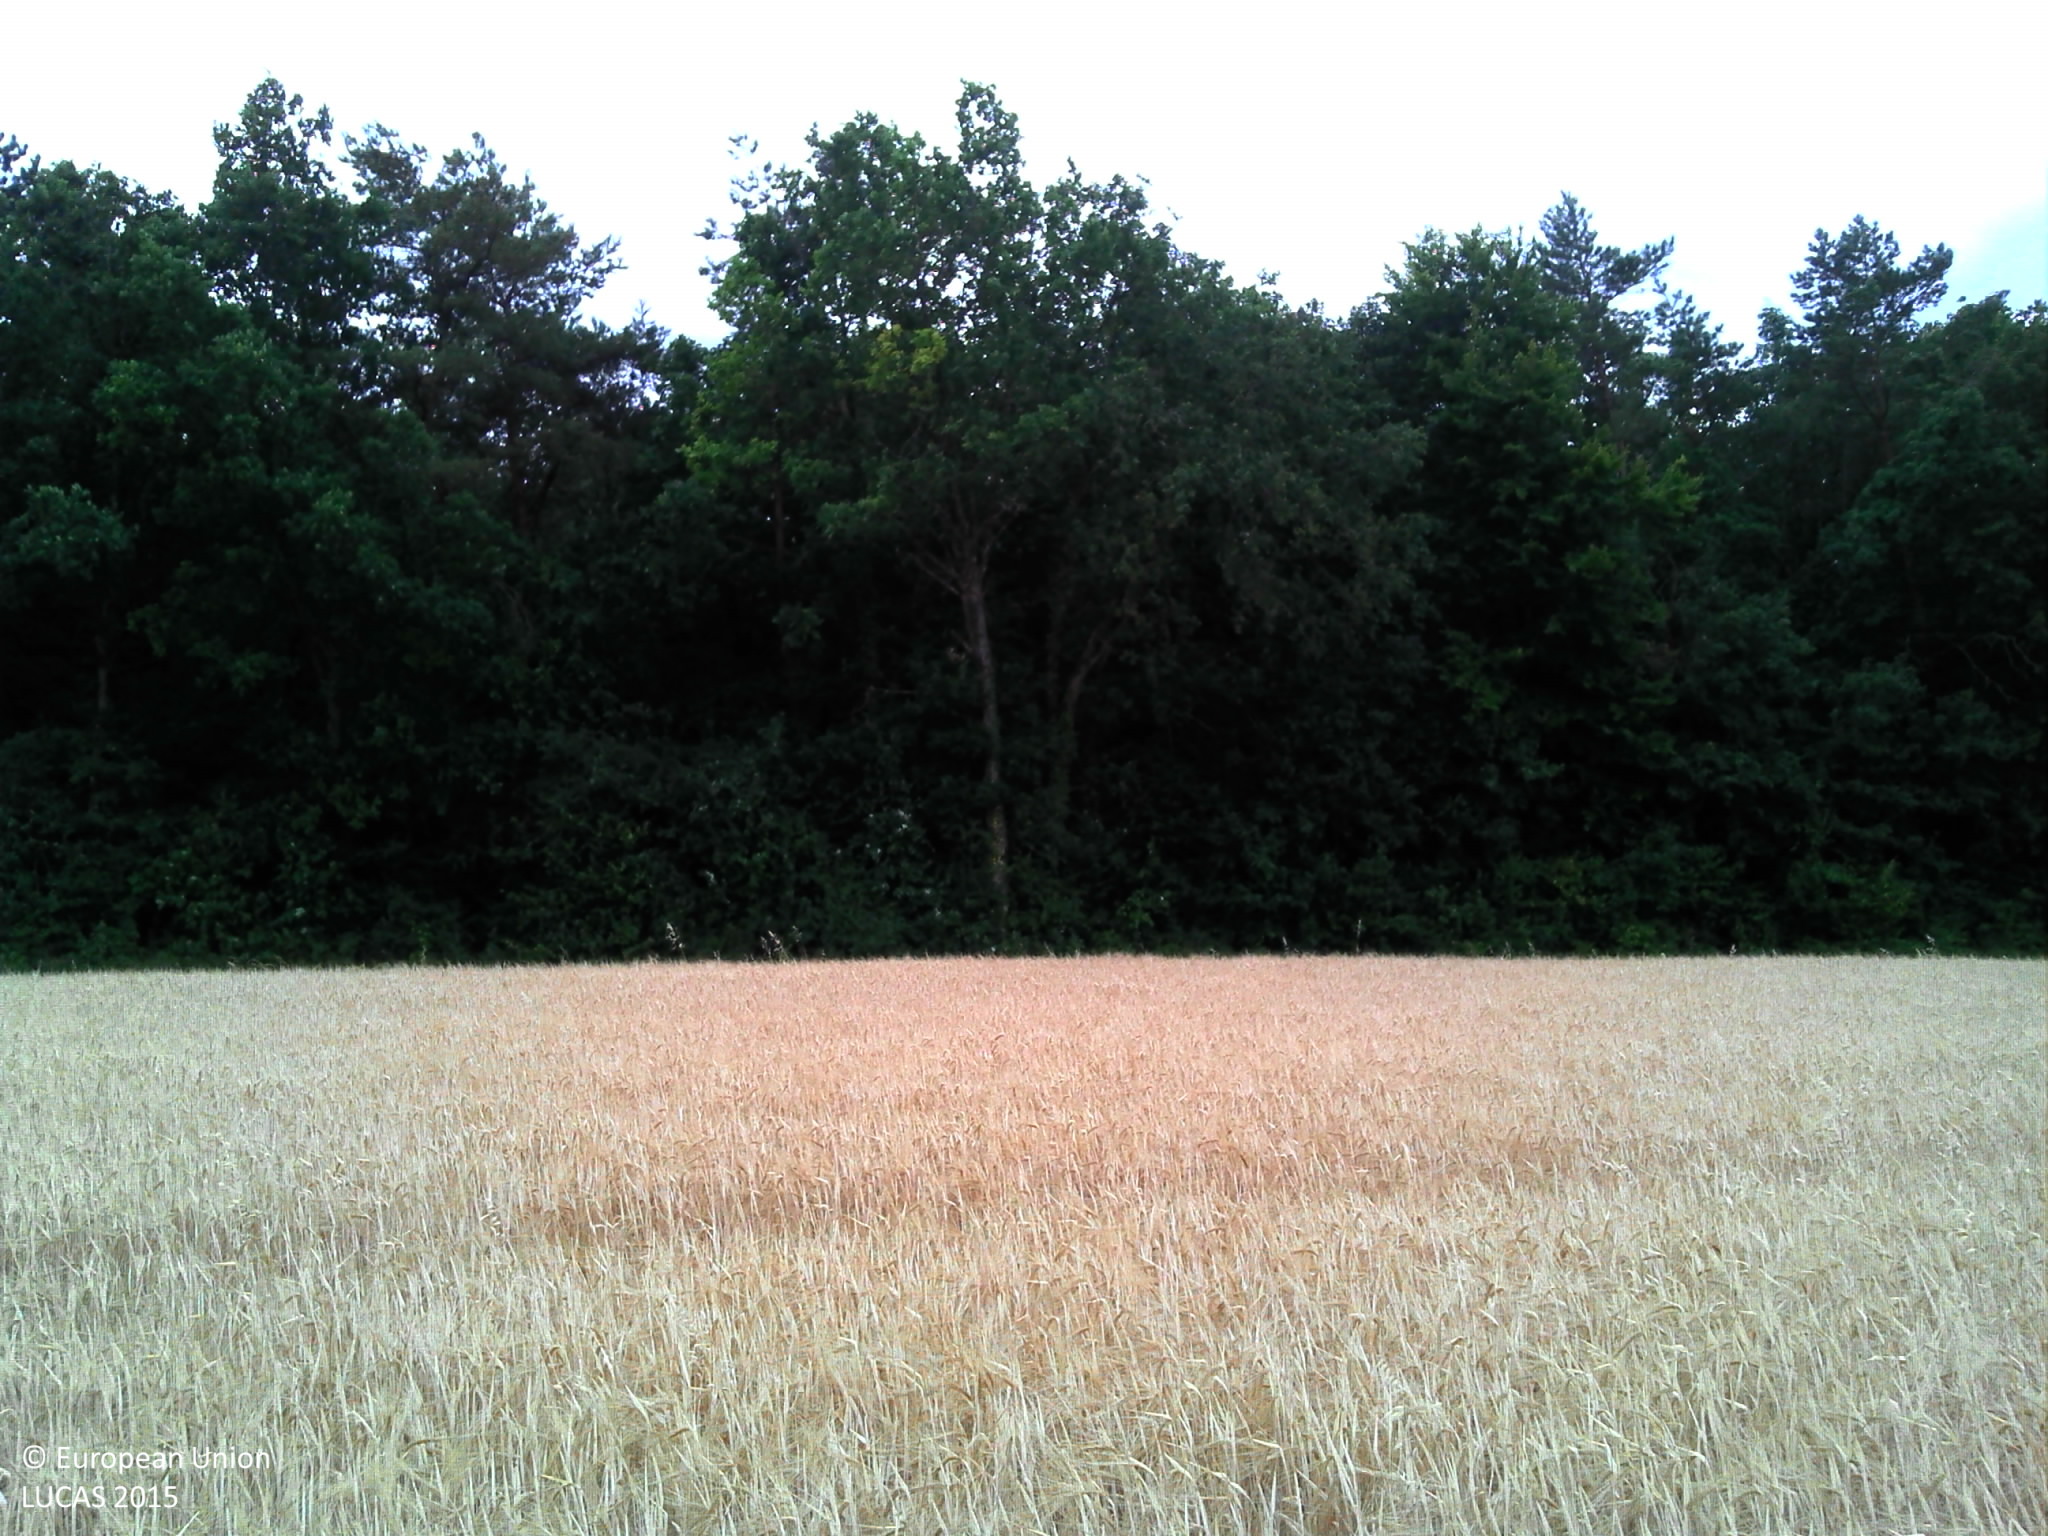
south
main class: Cropland
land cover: Barley
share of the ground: > 75 %
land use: Agriculture (excluding fallow land and kitchen gardens)
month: July
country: FR
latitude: 48.1527
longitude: 5.1465
